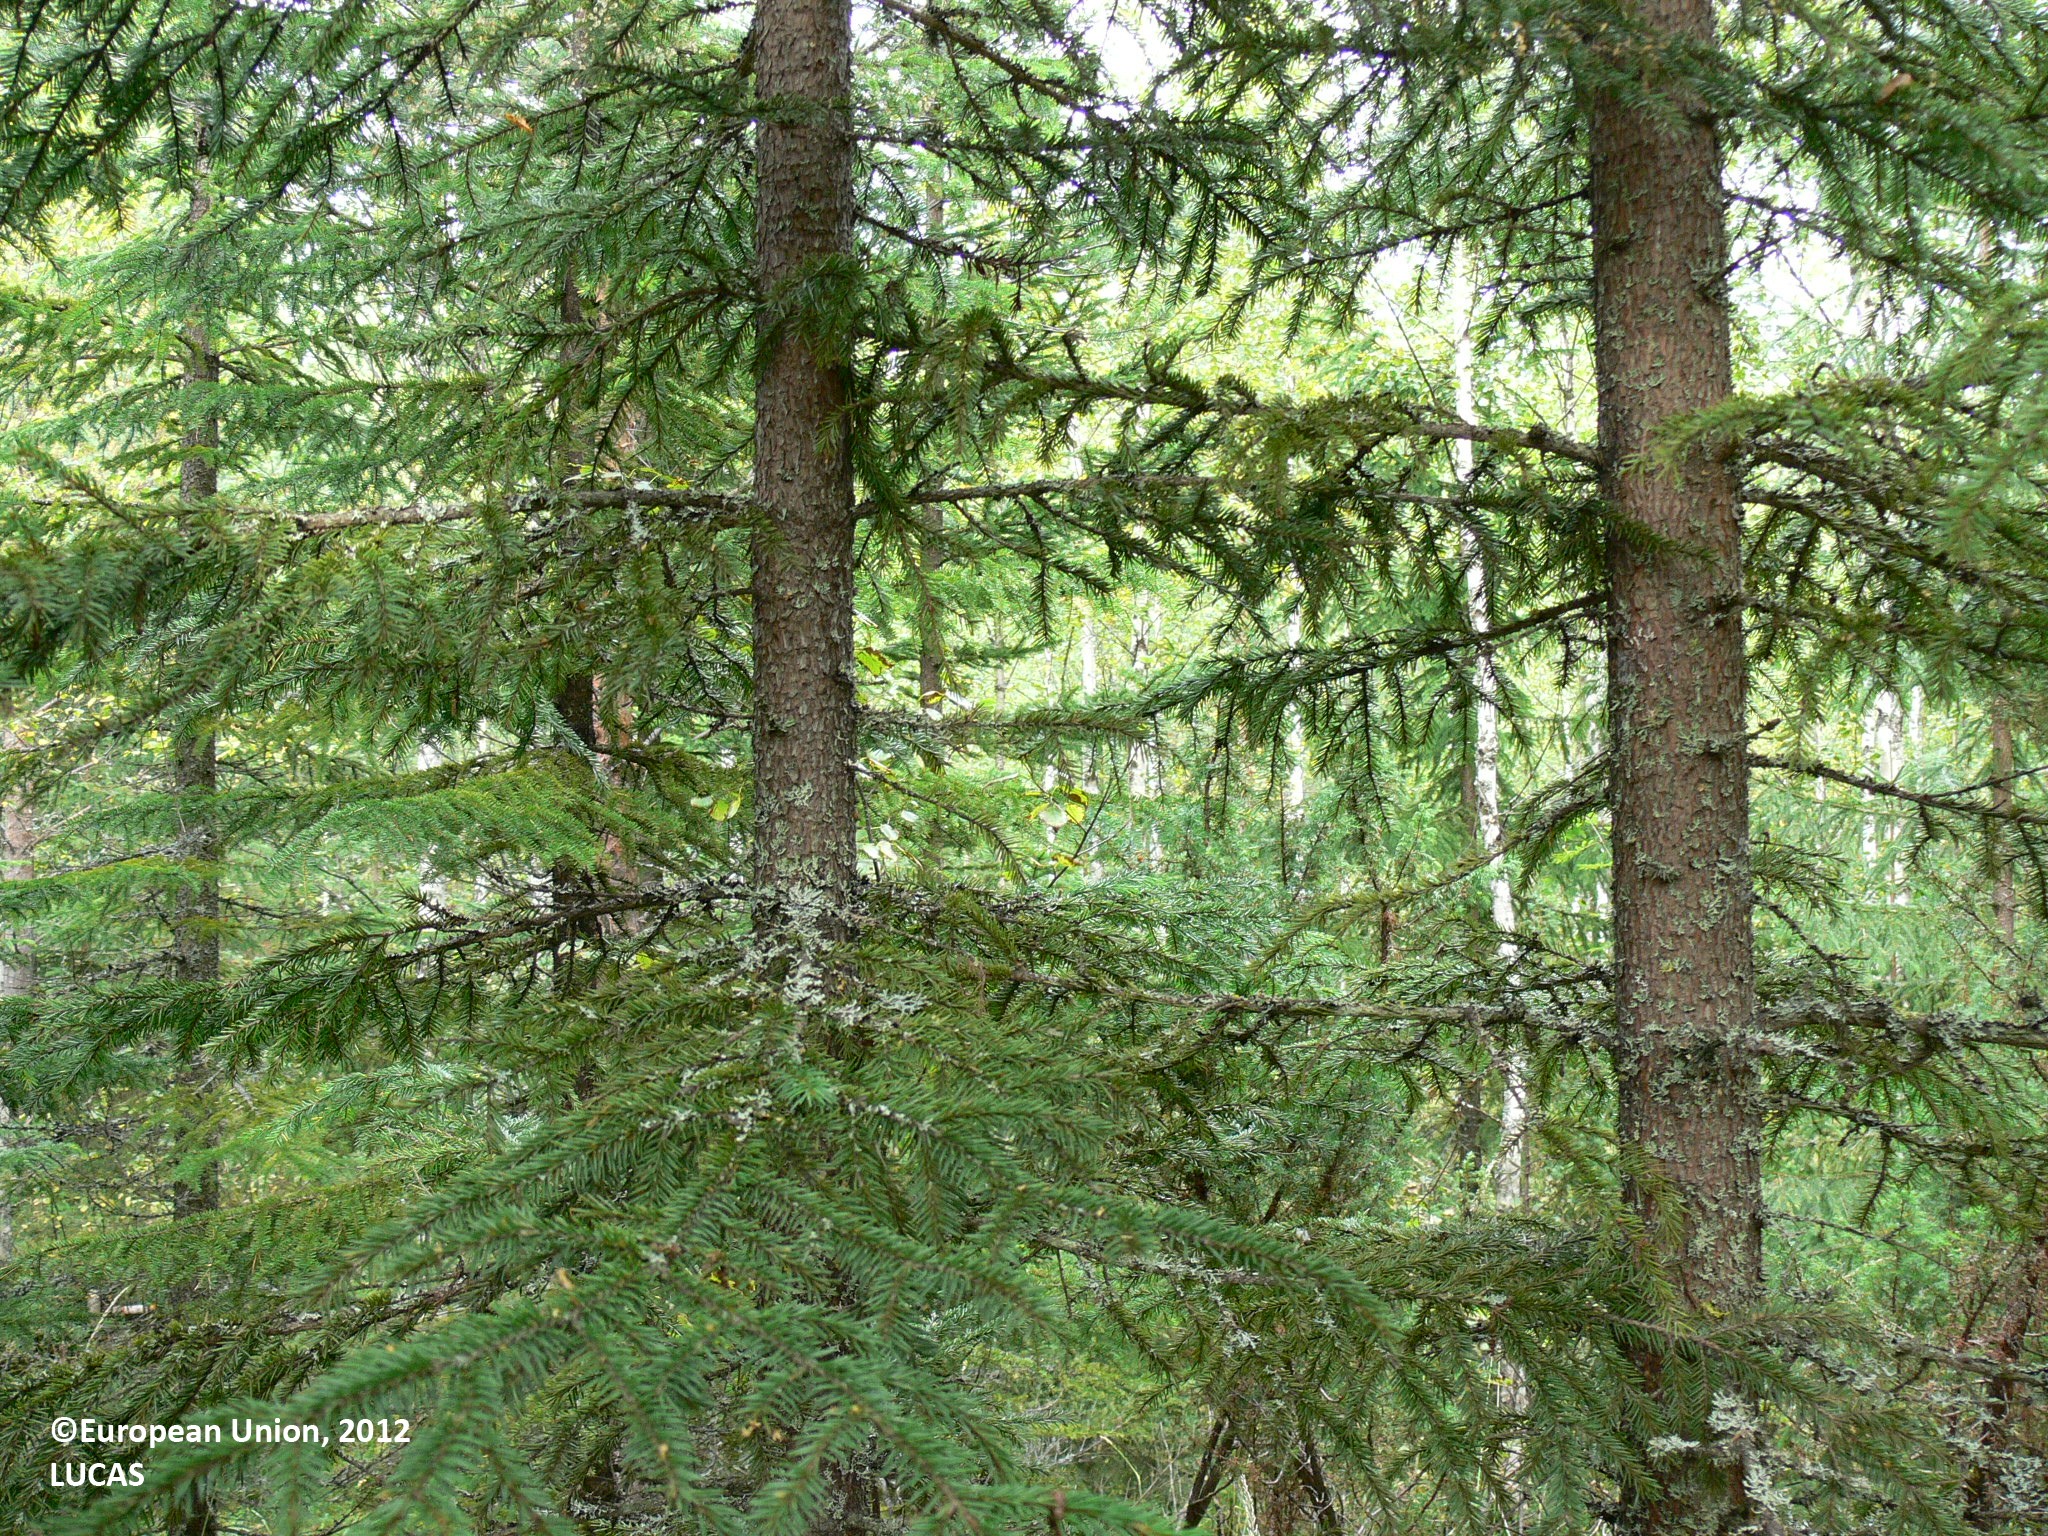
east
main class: Woodland
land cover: Spruce dominated mixed woodland
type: boreal forest
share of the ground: > 75 %
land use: Forestry
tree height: > 5 m
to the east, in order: Spruce dominated mixed woodland; Other mixed woodland; Pine dominated coniferous woodland
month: August
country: FI
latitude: 63.3512
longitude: 30.0981
